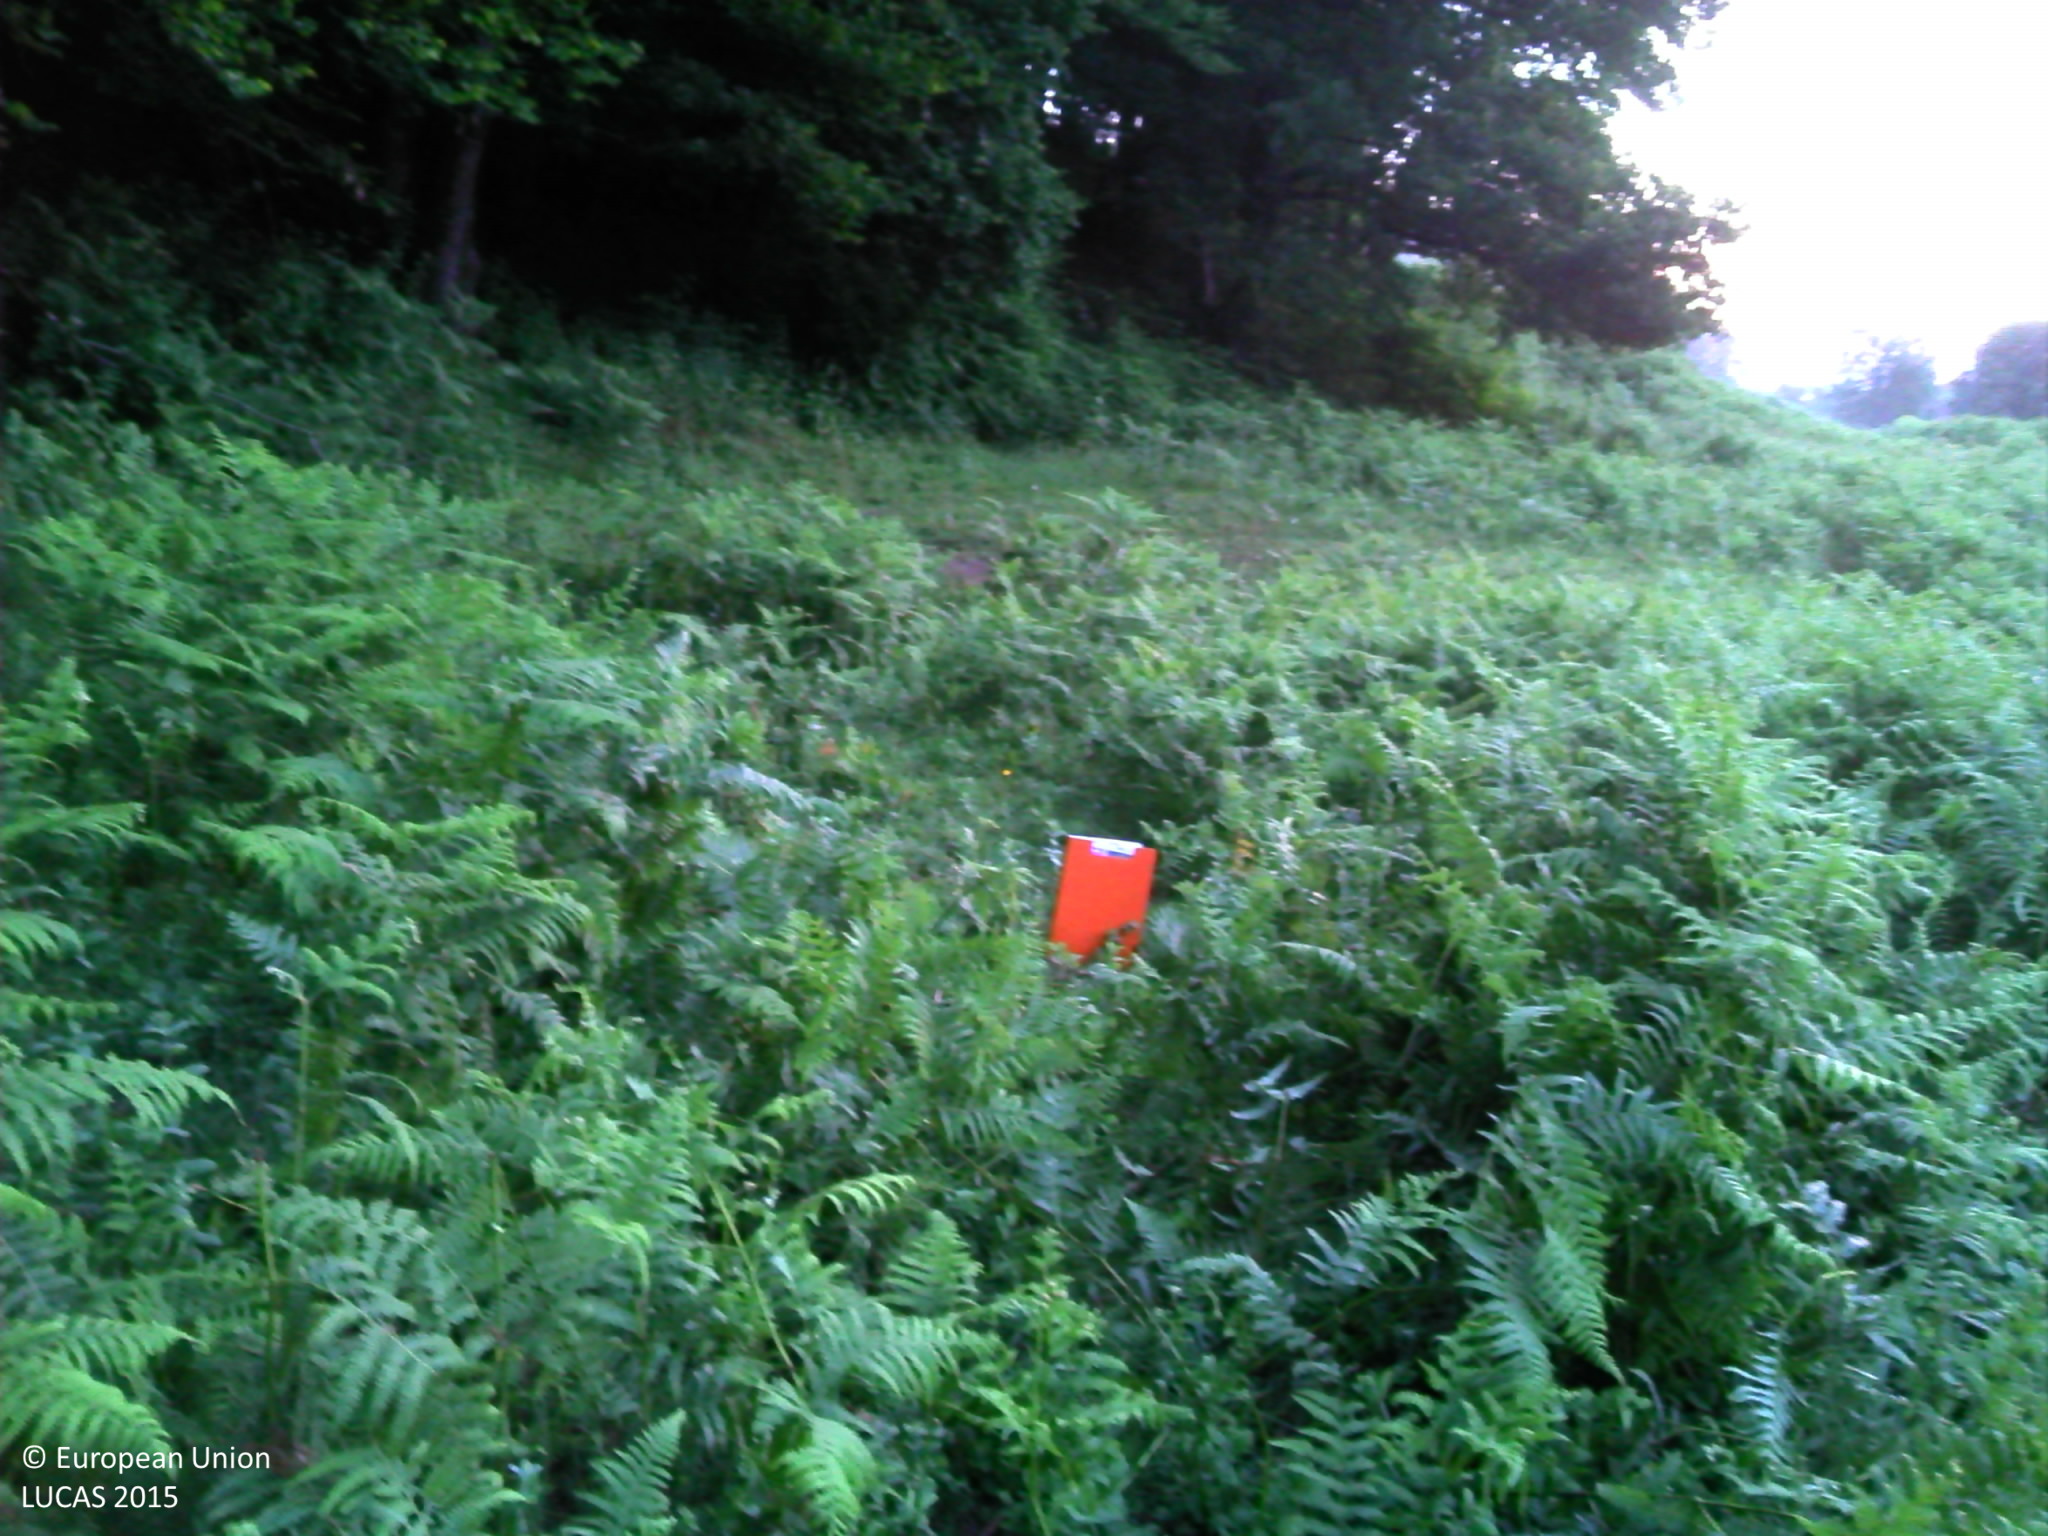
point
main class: Shrubland
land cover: Shrubland without tree cover
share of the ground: > 75 %
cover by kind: shrubs 70 %, herbaceous plants 30 %
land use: Agriculture (excluding fallow land and kitchen gardens)
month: June
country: FR
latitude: 45.3250
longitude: 2.4589
